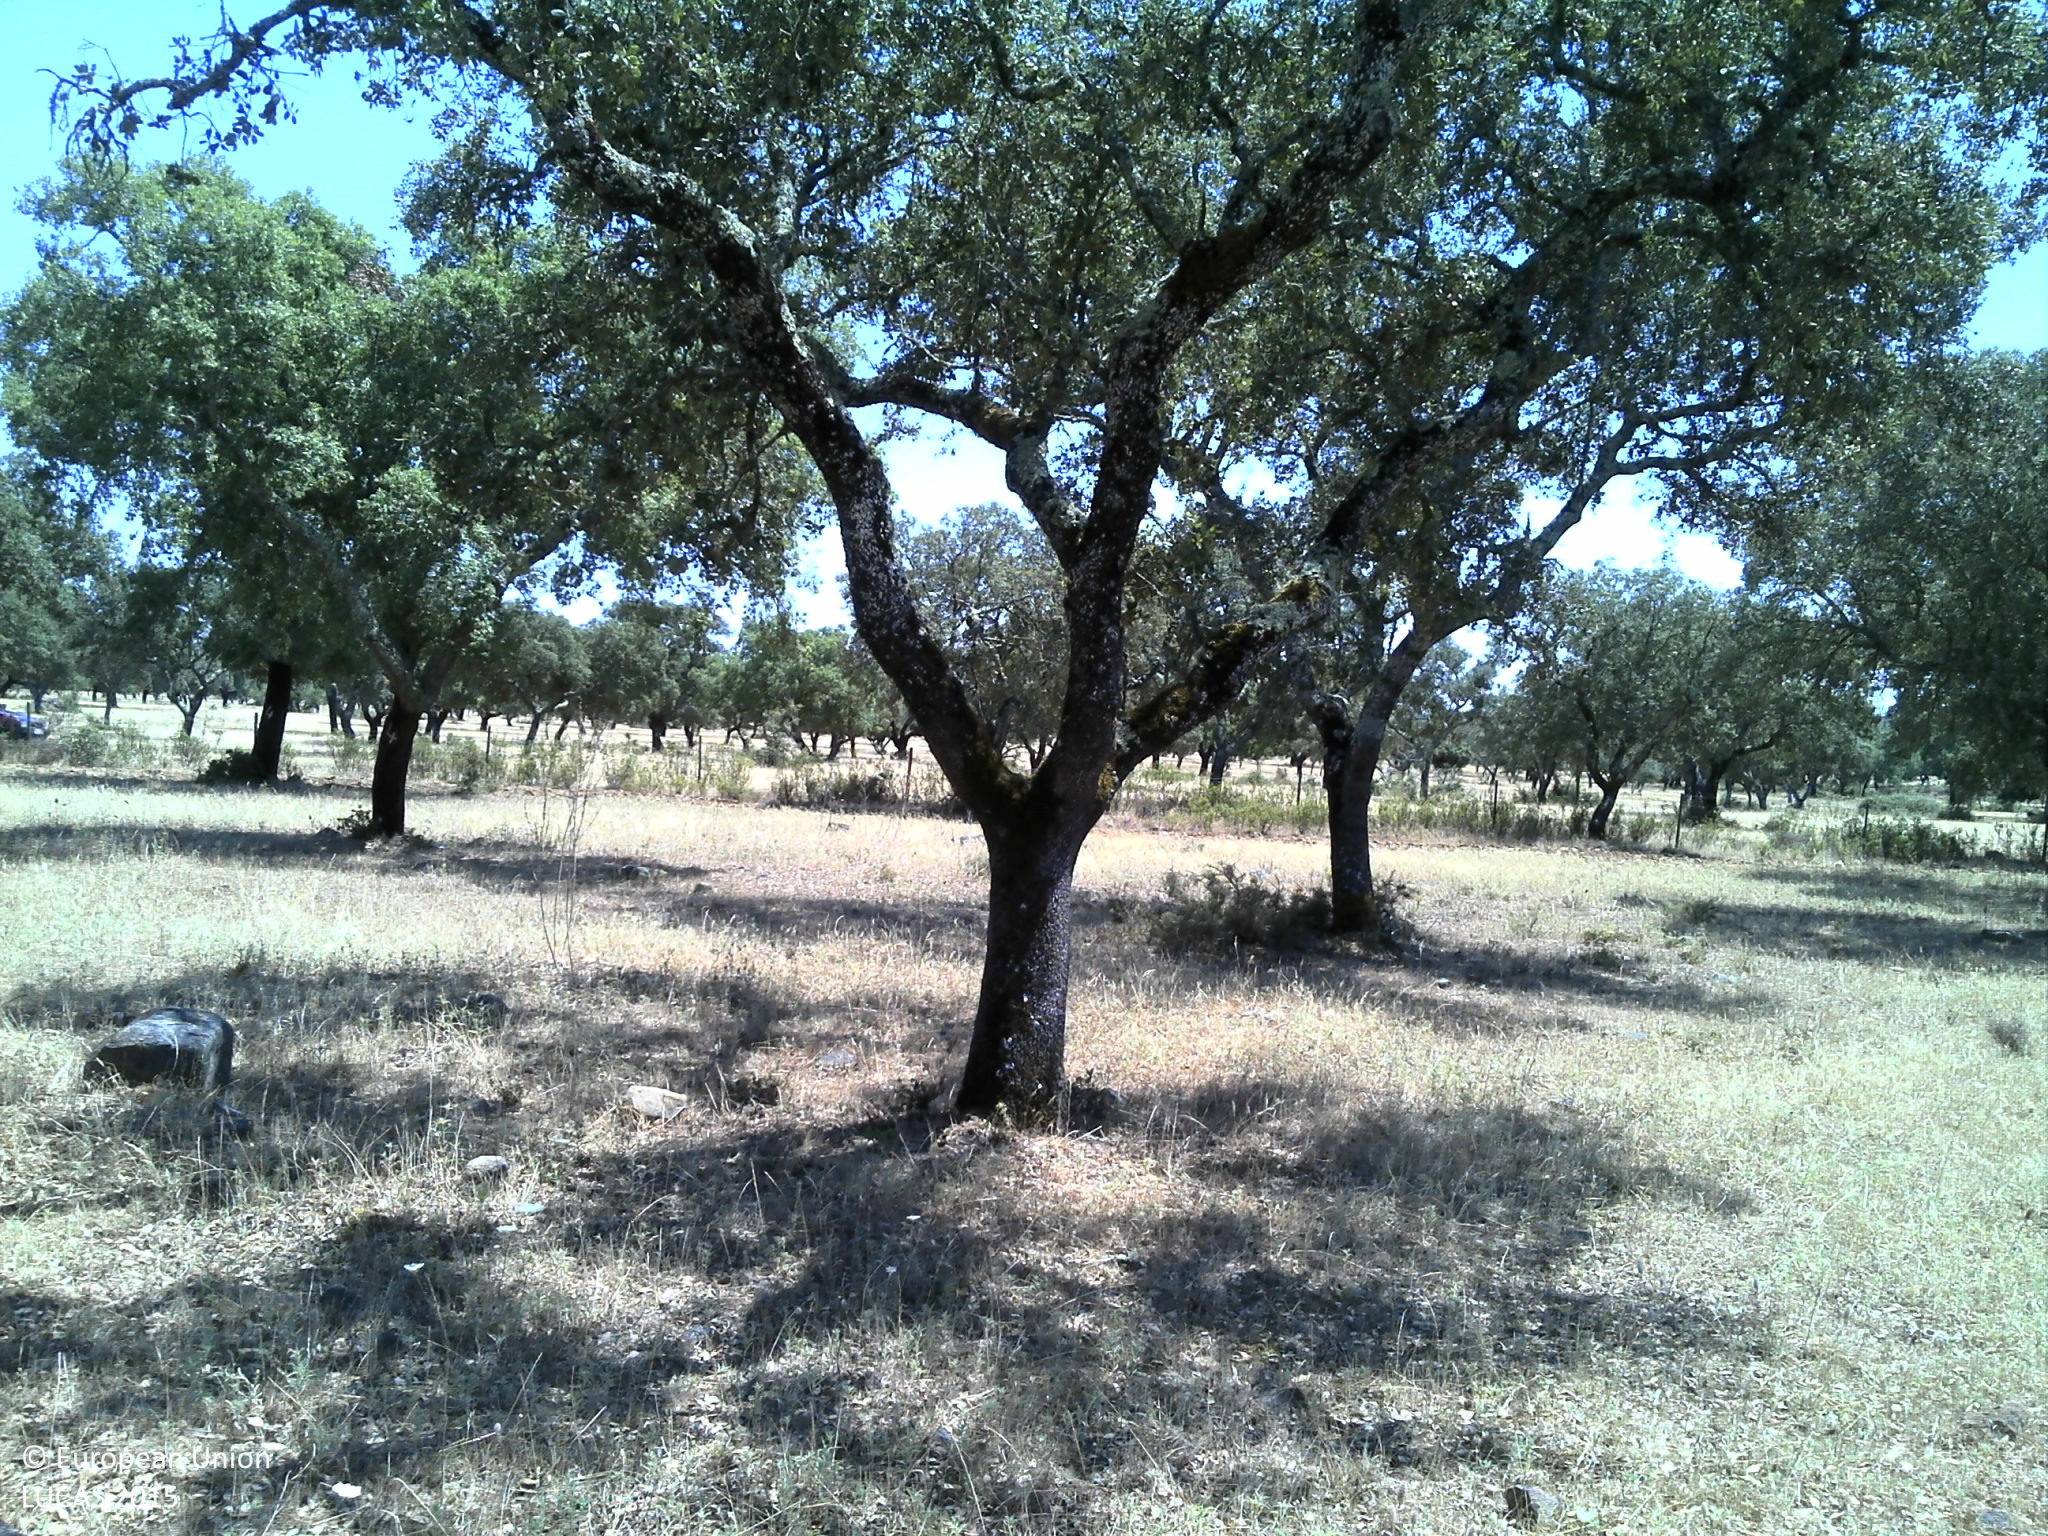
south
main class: Woodland
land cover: Broadleaved woodland
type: broadleaved evergreen forest
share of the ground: 10 - 25 %
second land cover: Grassland without tree/shrub cover
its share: 25 - 50 %
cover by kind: unconsolidated bare surface 50 %, broadleaved forest trees 25 %, herbaceous plants 25 %
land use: Forestry
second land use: Agriculture (excluding fallow land and kitchen gardens)
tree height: > 5 m
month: June
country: PT
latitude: 38.3537
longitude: -8.1560
